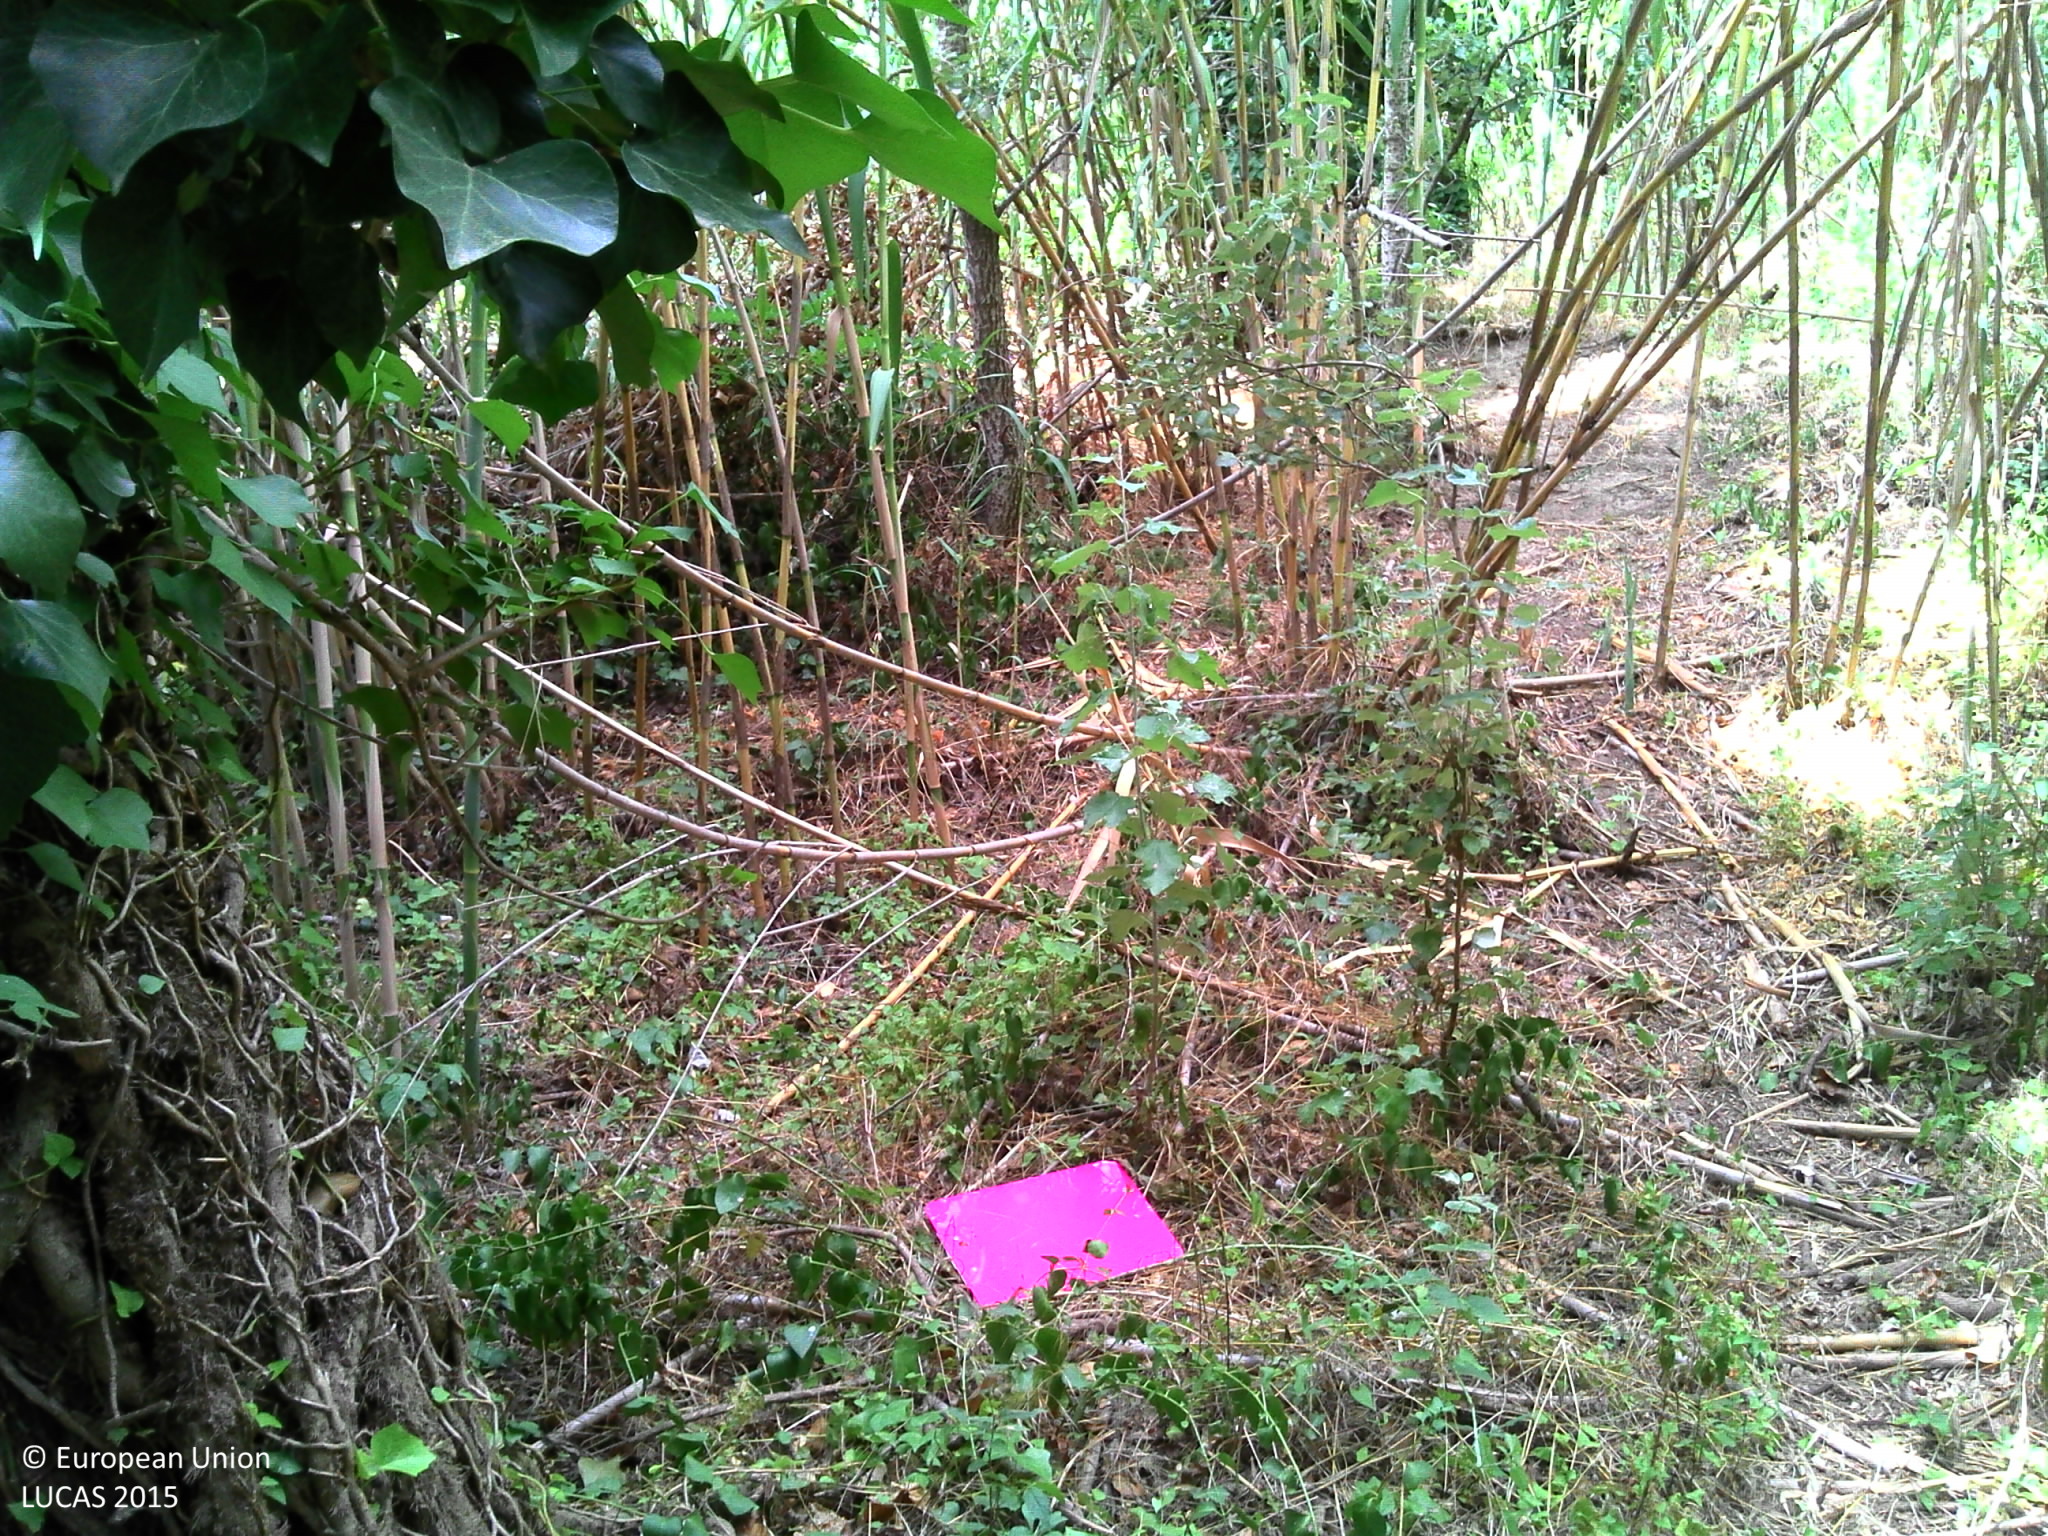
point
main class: Woodland
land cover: Broadleaved woodland
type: mesophytic deciduous forest
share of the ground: > 75 %
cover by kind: broadleaved forest trees 90 %, shrubs 10 %
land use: Semi-natural and natural areas not in use
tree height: > 5 m
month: July
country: FR
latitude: 42.6857
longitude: 2.7744
